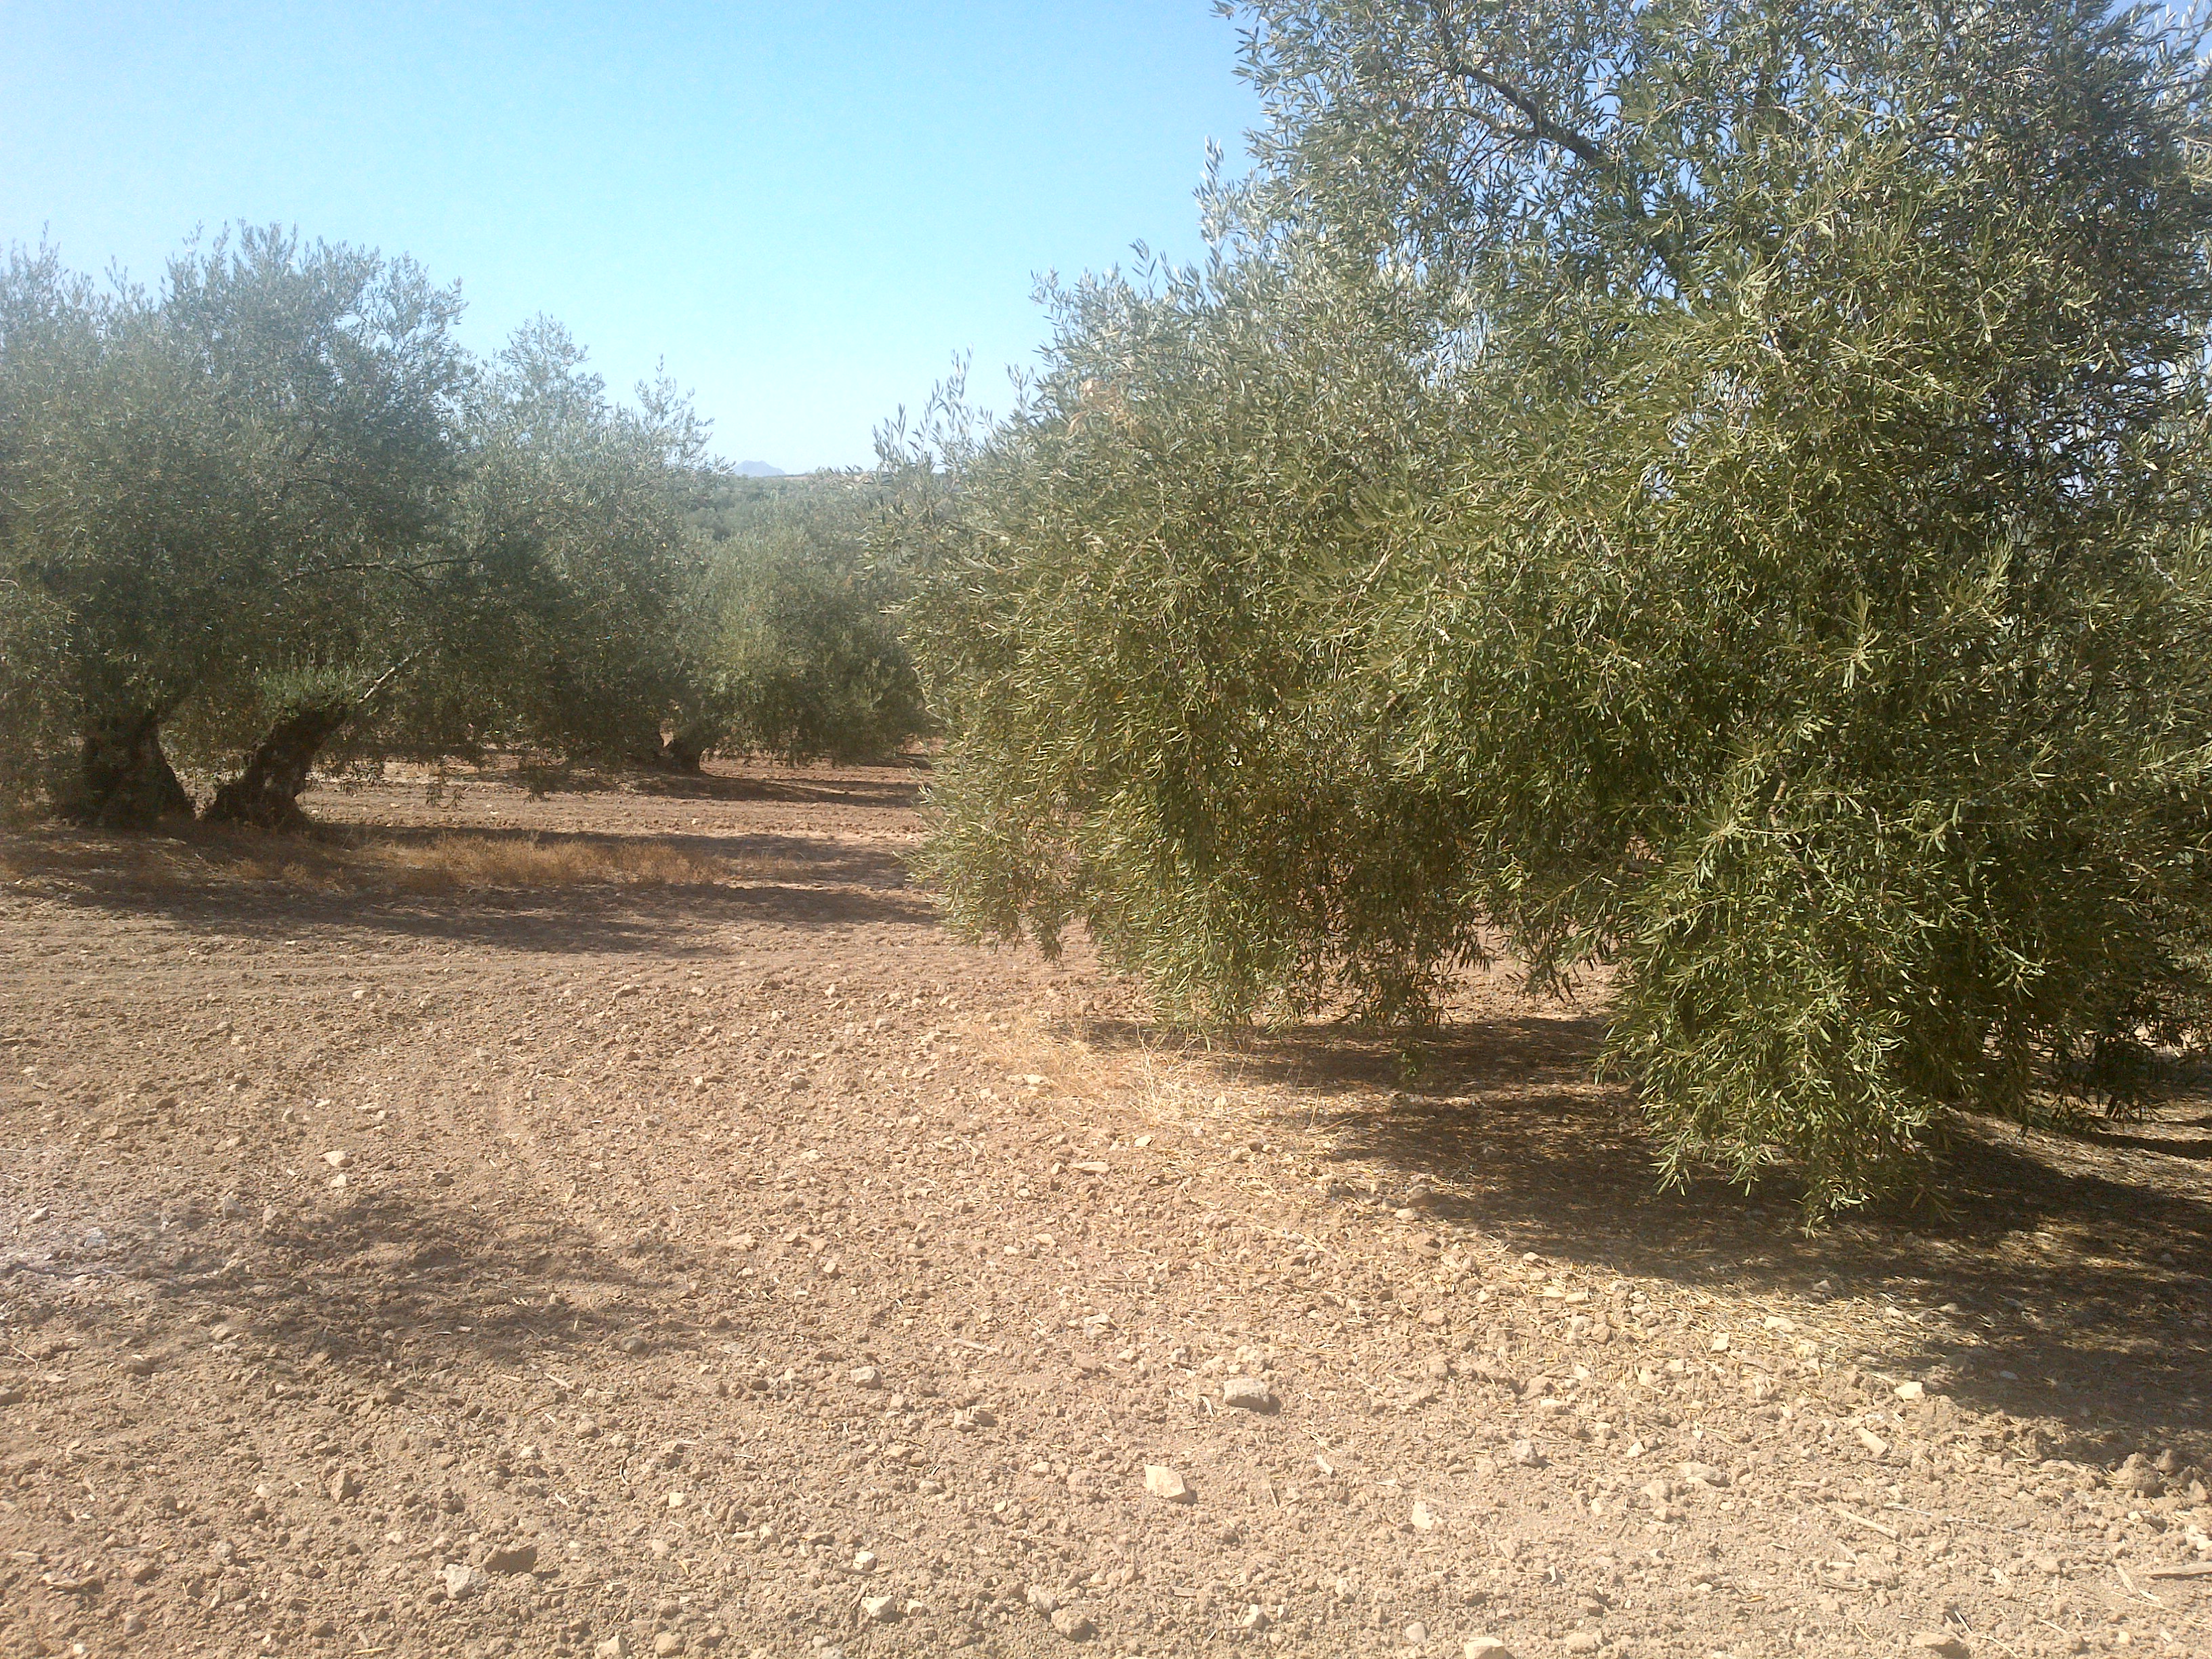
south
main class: Cropland
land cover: Olive groves
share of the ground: 50 - 75 %
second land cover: Other bare soil
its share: > 75 %
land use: Agriculture (excluding fallow land and kitchen gardens)
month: July
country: ES
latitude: 37.4041
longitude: -4.8400
